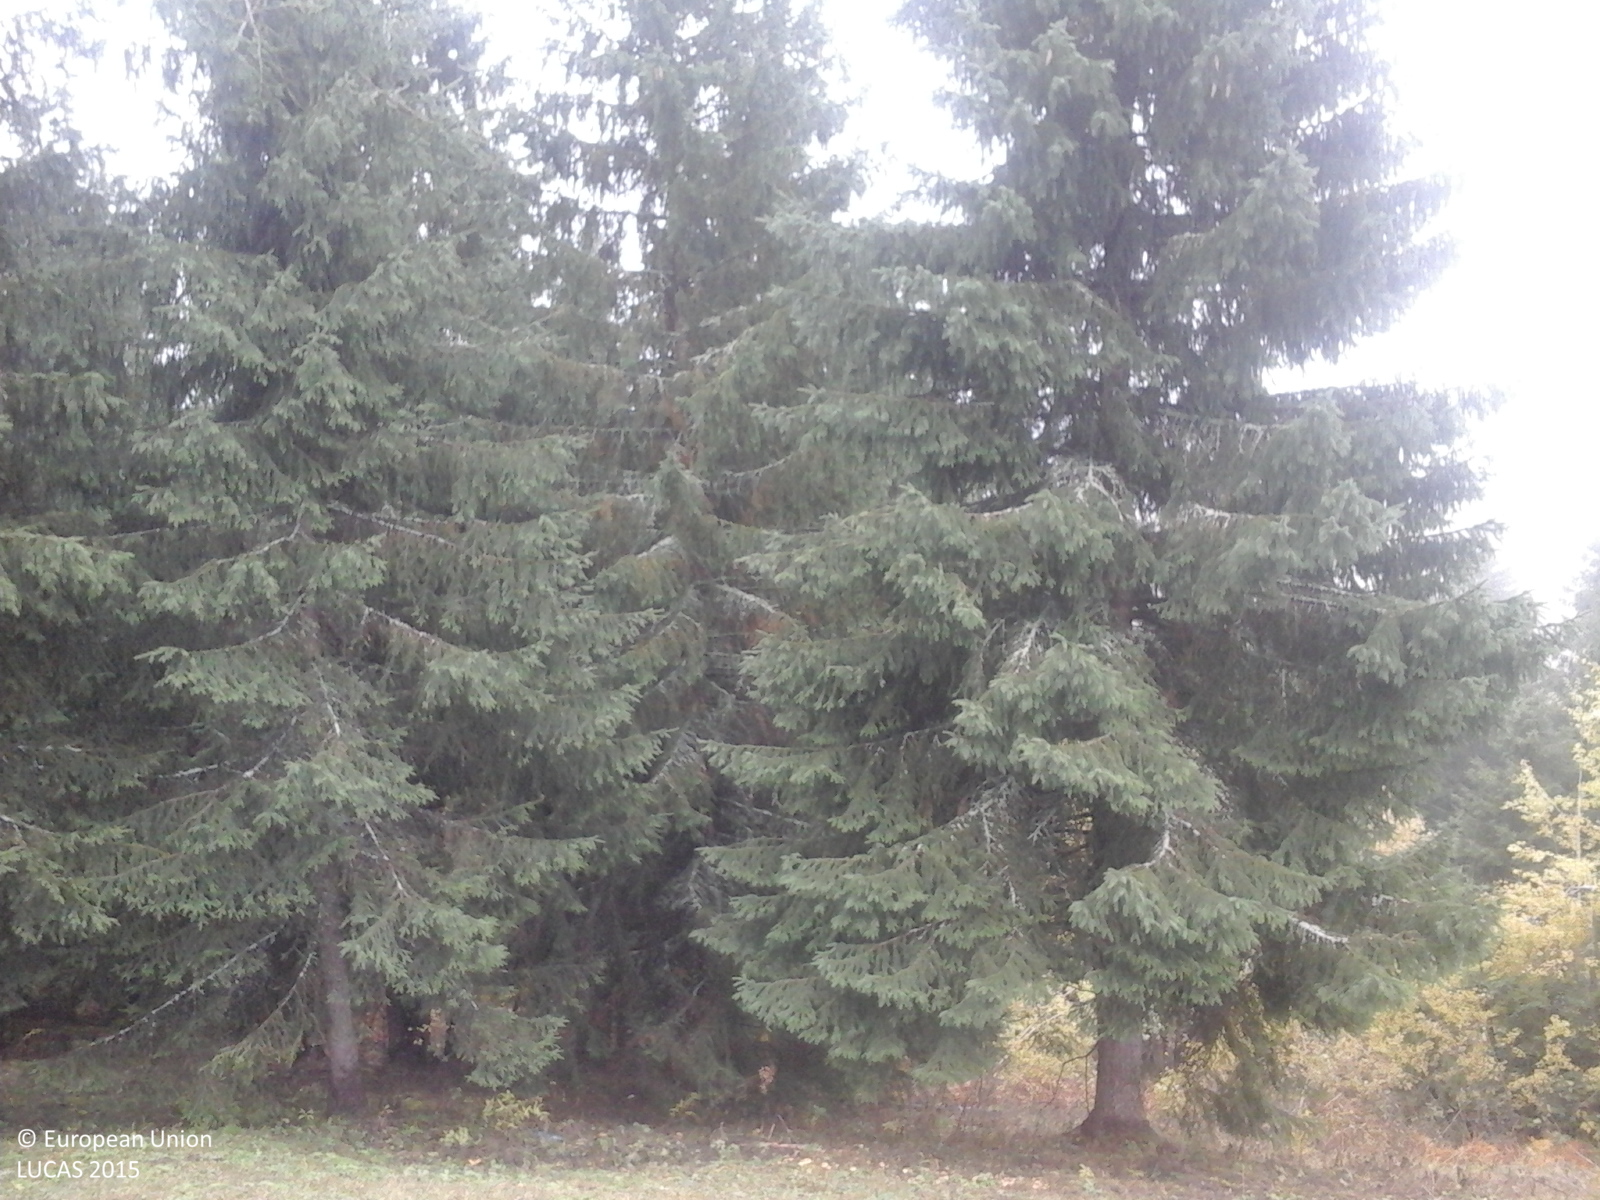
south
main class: Grassland
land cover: Grassland without tree/shrub cover
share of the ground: > 75 %
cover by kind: herbaceous plants 100 %
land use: Agriculture (excluding fallow land and kitchen gardens)
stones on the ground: < 10 %
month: October
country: RO
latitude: 46.5505
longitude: 25.9938
